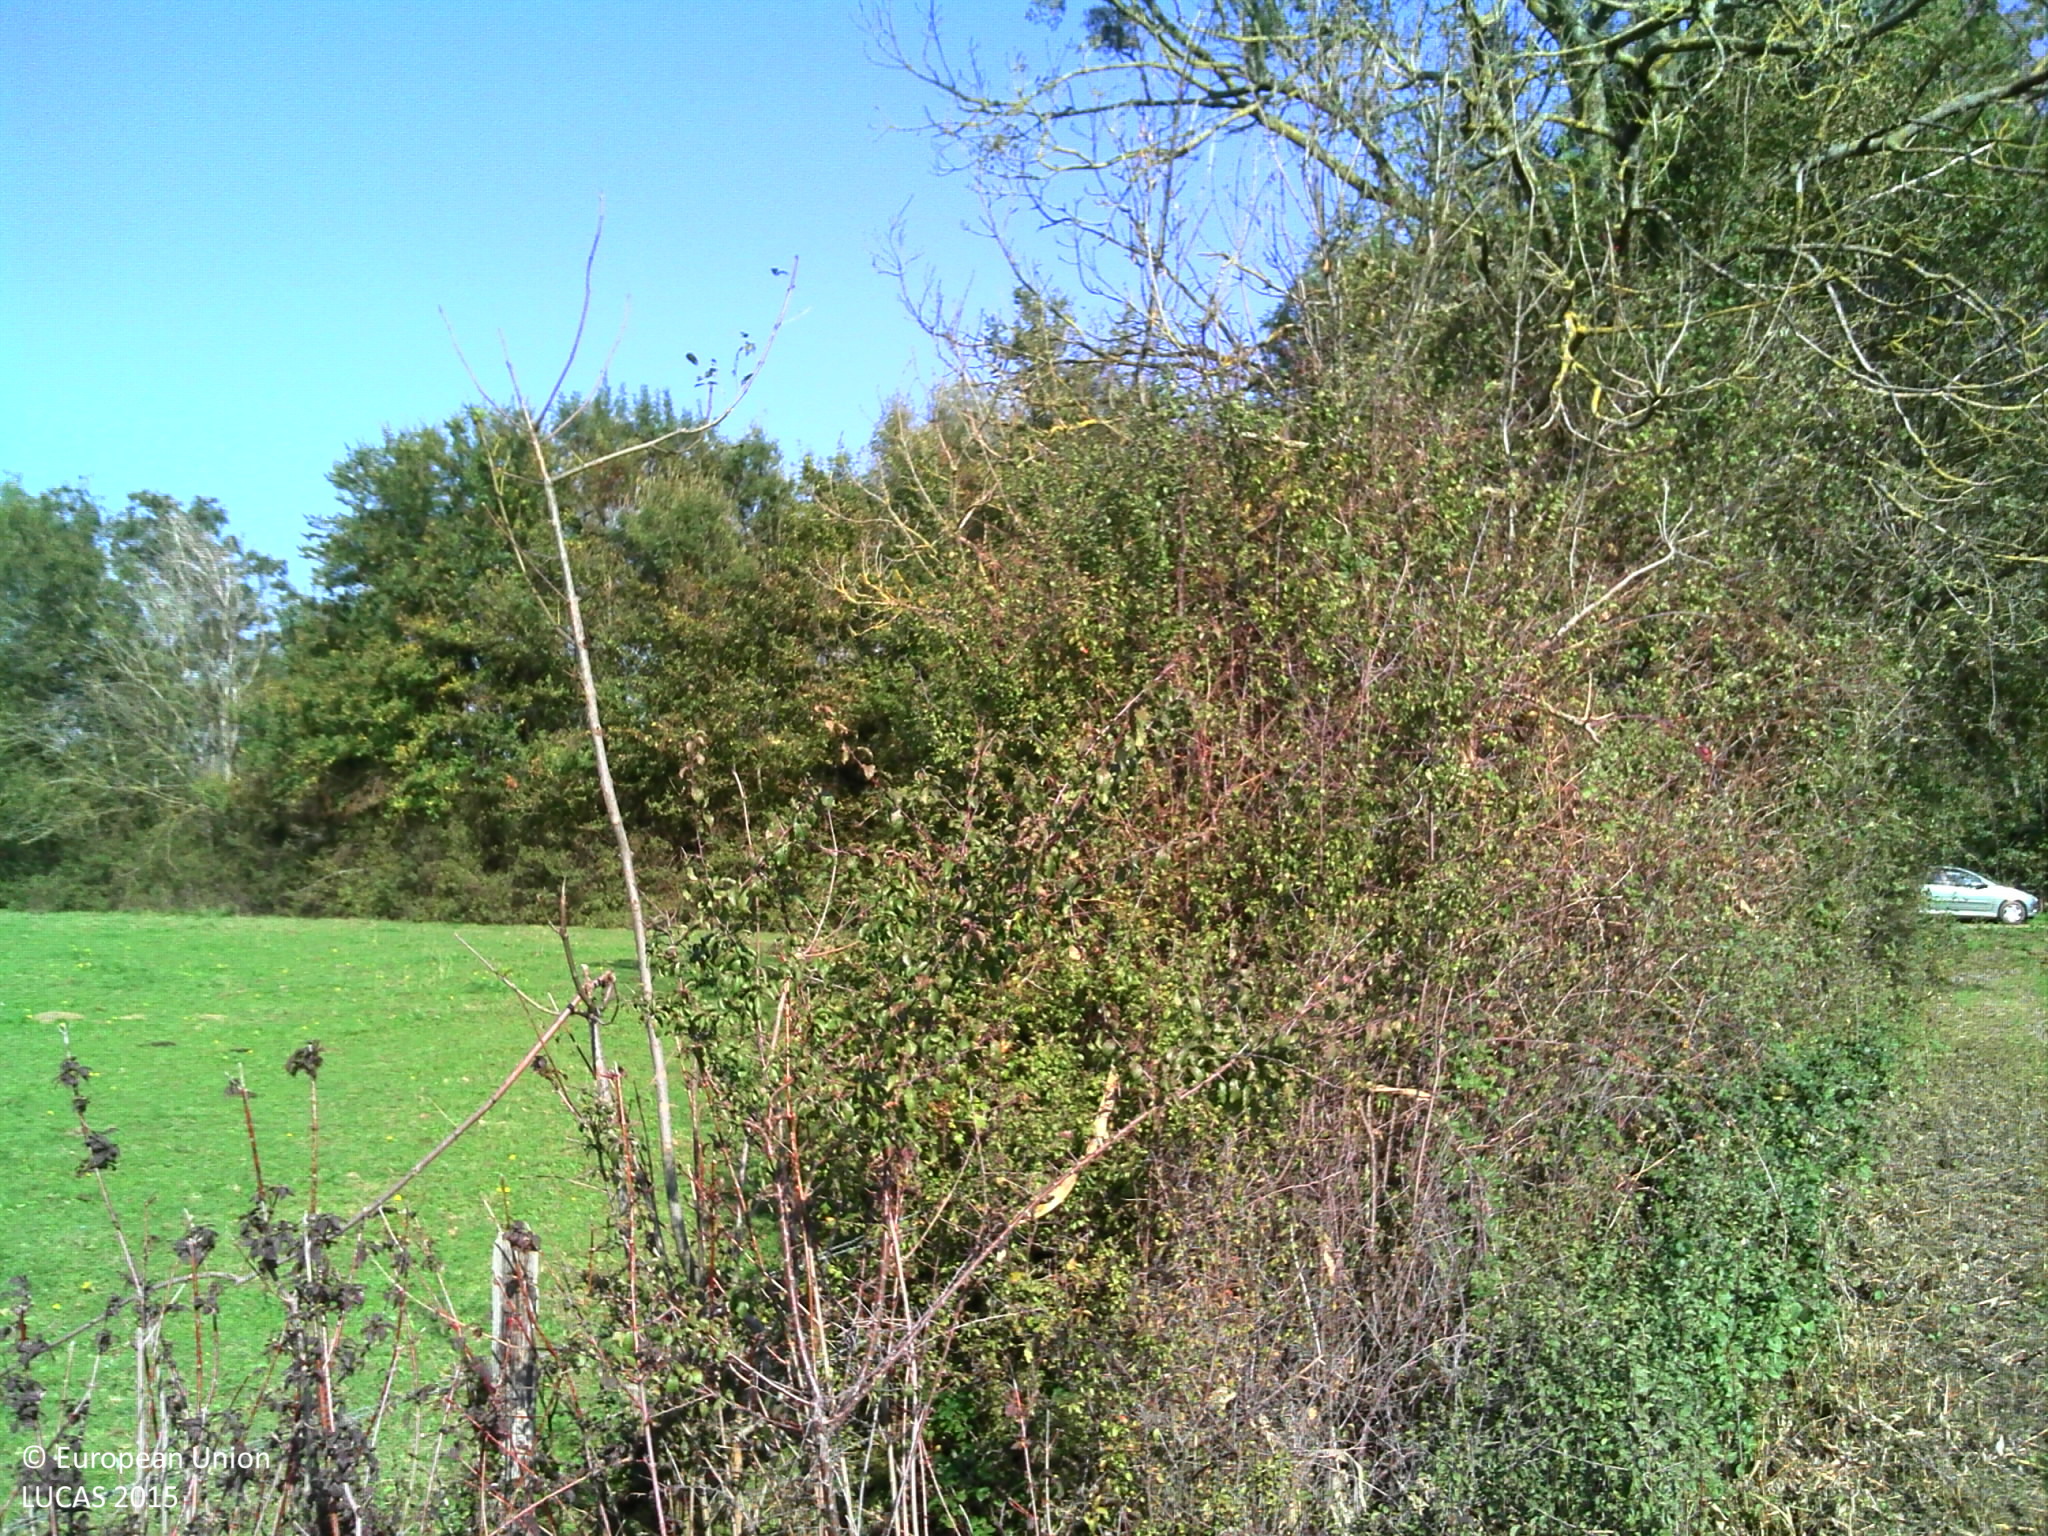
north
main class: Grassland
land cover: Grassland without tree/shrub cover
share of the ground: > 75 %
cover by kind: herbaceous plants 100 %
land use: Agriculture (excluding fallow land and kitchen gardens)
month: October
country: FR
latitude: 46.3185
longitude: 4.8724
